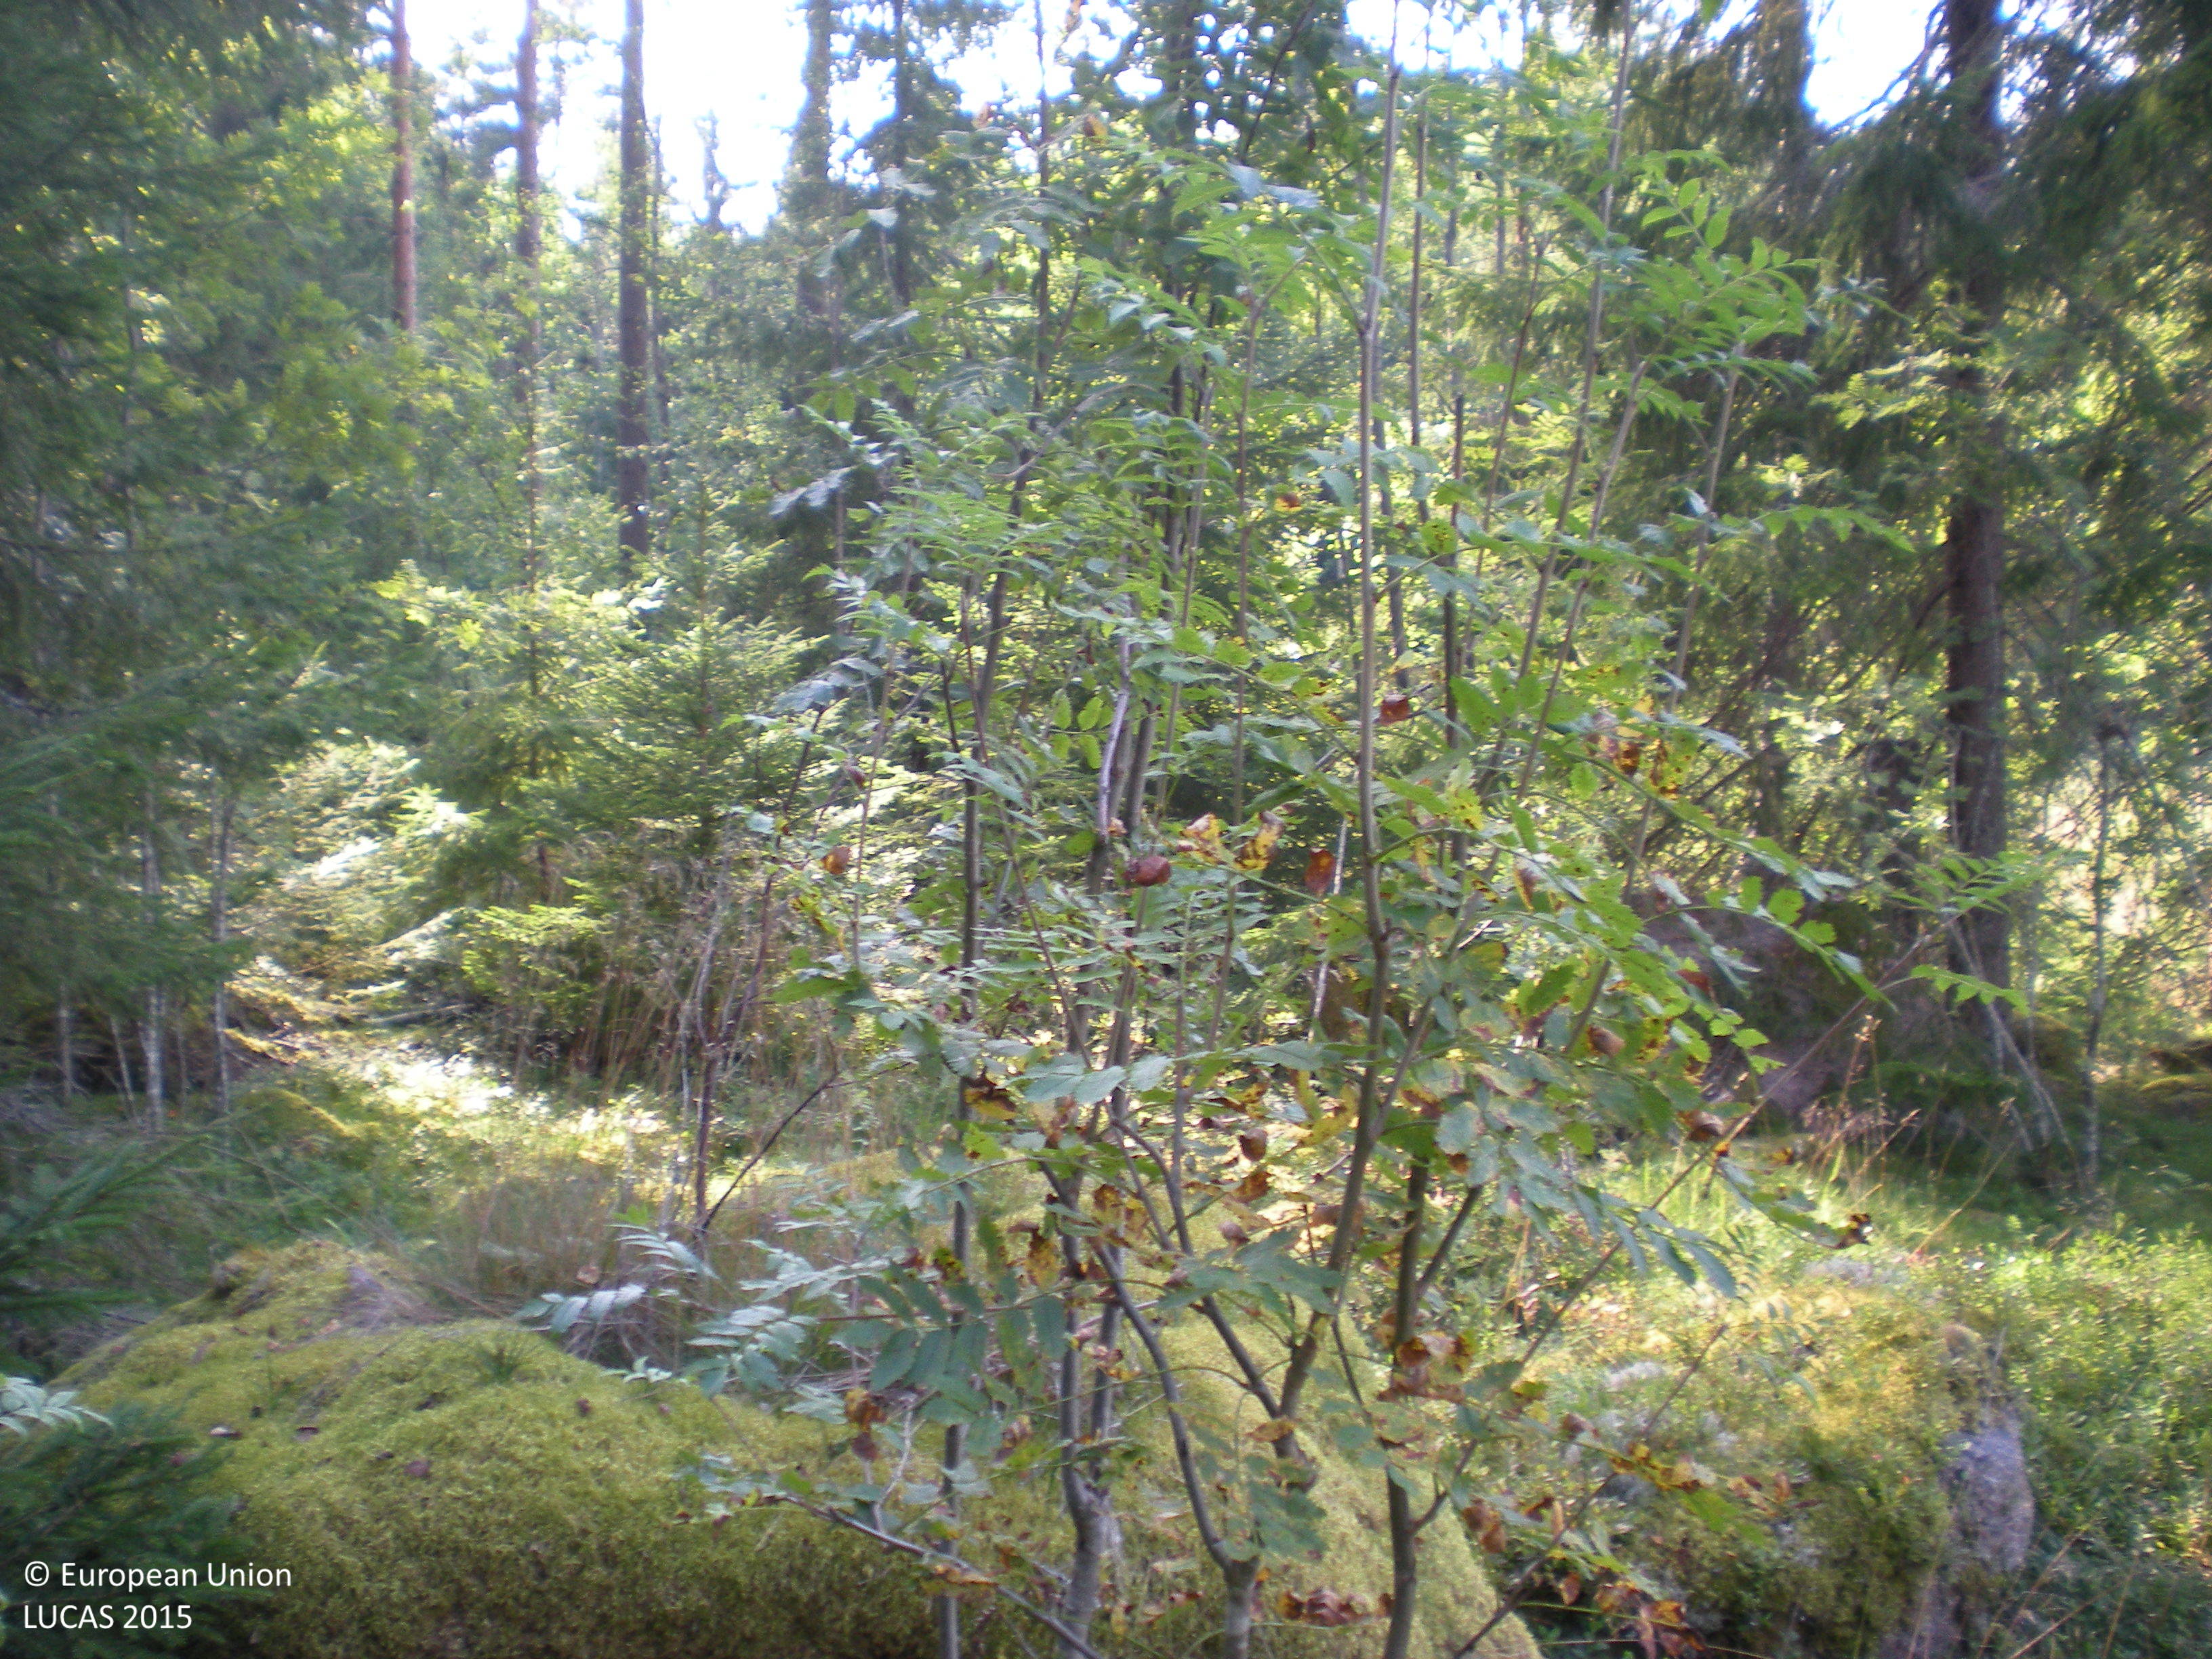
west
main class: Woodland
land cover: Spruce dominated coniferous woodland
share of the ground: 50 - 75 %
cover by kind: coniferous forest trees 50 %, shrubs 20 %, broadleaved forest trees 10 %, lichens and mosses 10 %, herbaceous plants 5 %, consolidated bare surface 5 %
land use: Forestry
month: August
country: SE
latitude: 60.3842
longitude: 17.0469
